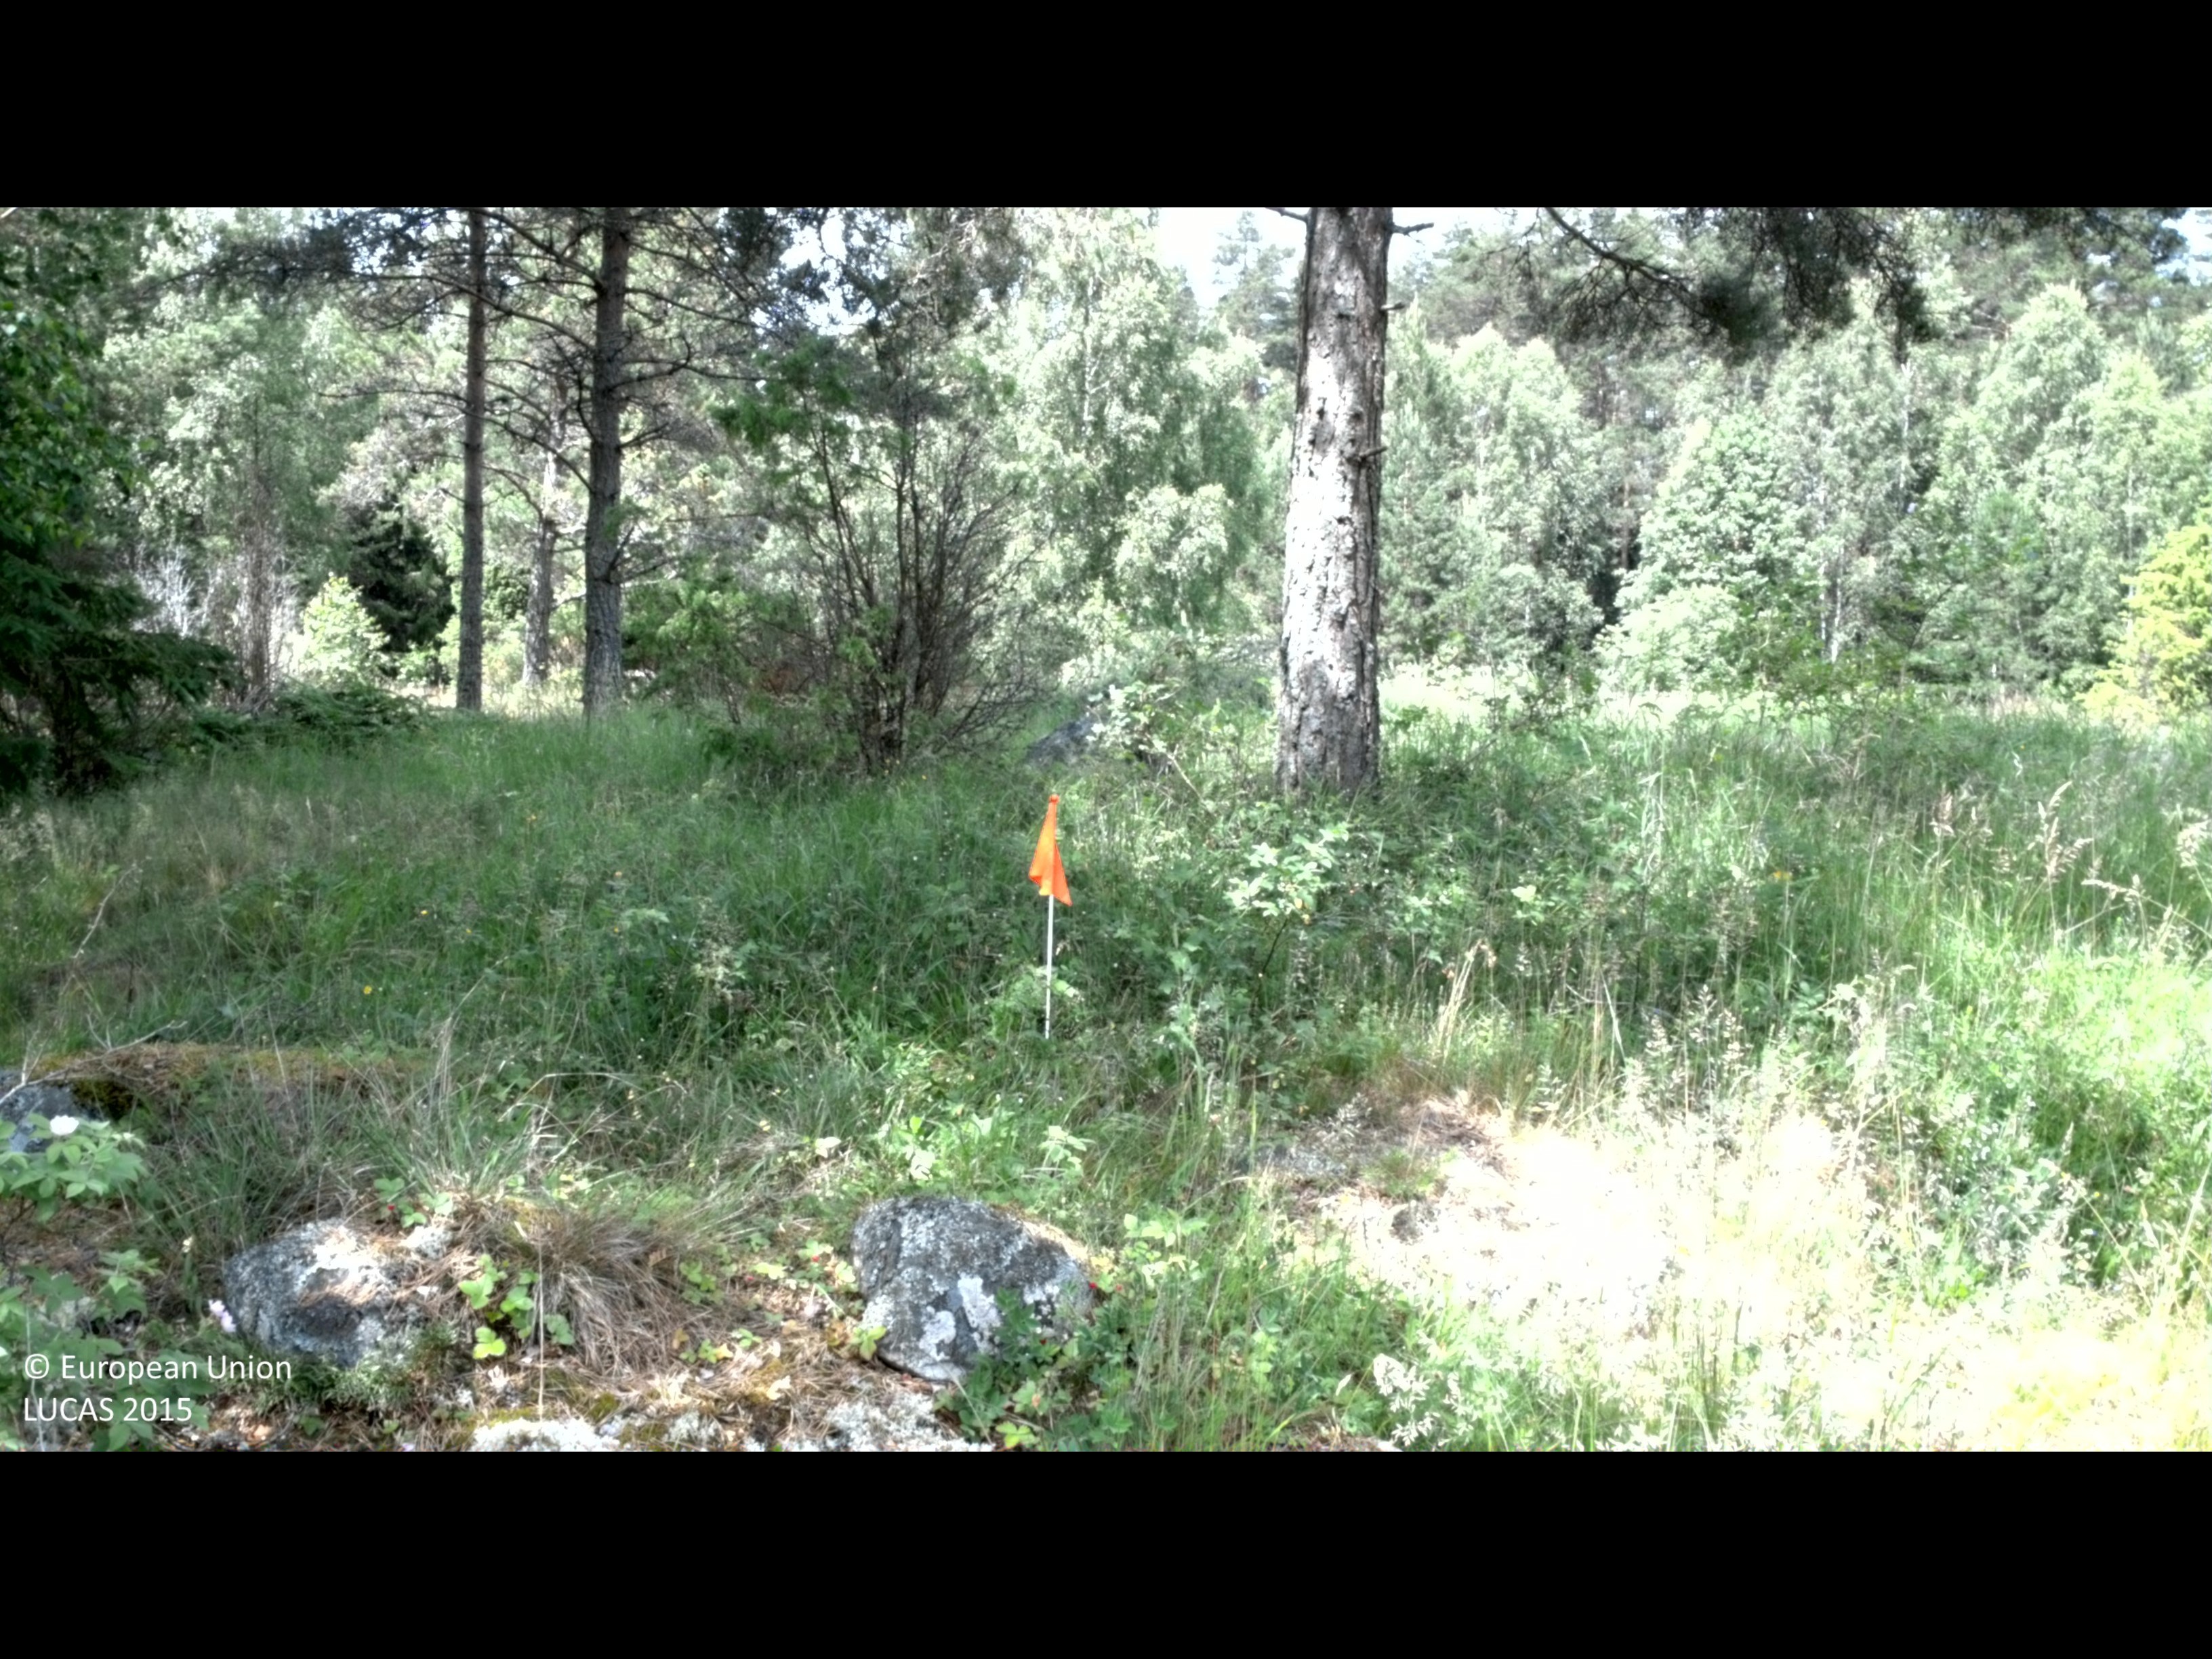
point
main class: Woodland
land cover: Pine dominated mixed woodland
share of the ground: 25 - 50 %
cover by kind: herbaceous plants 35 %, coniferous forest trees 30 %, shrubs 20 %, broadleaved forest trees 15 %
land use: Agriculture (excluding fallow land and kitchen gardens)
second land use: Forestry
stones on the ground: 25 - 50 %
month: June
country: SE
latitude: 58.0221
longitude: 16.5835
